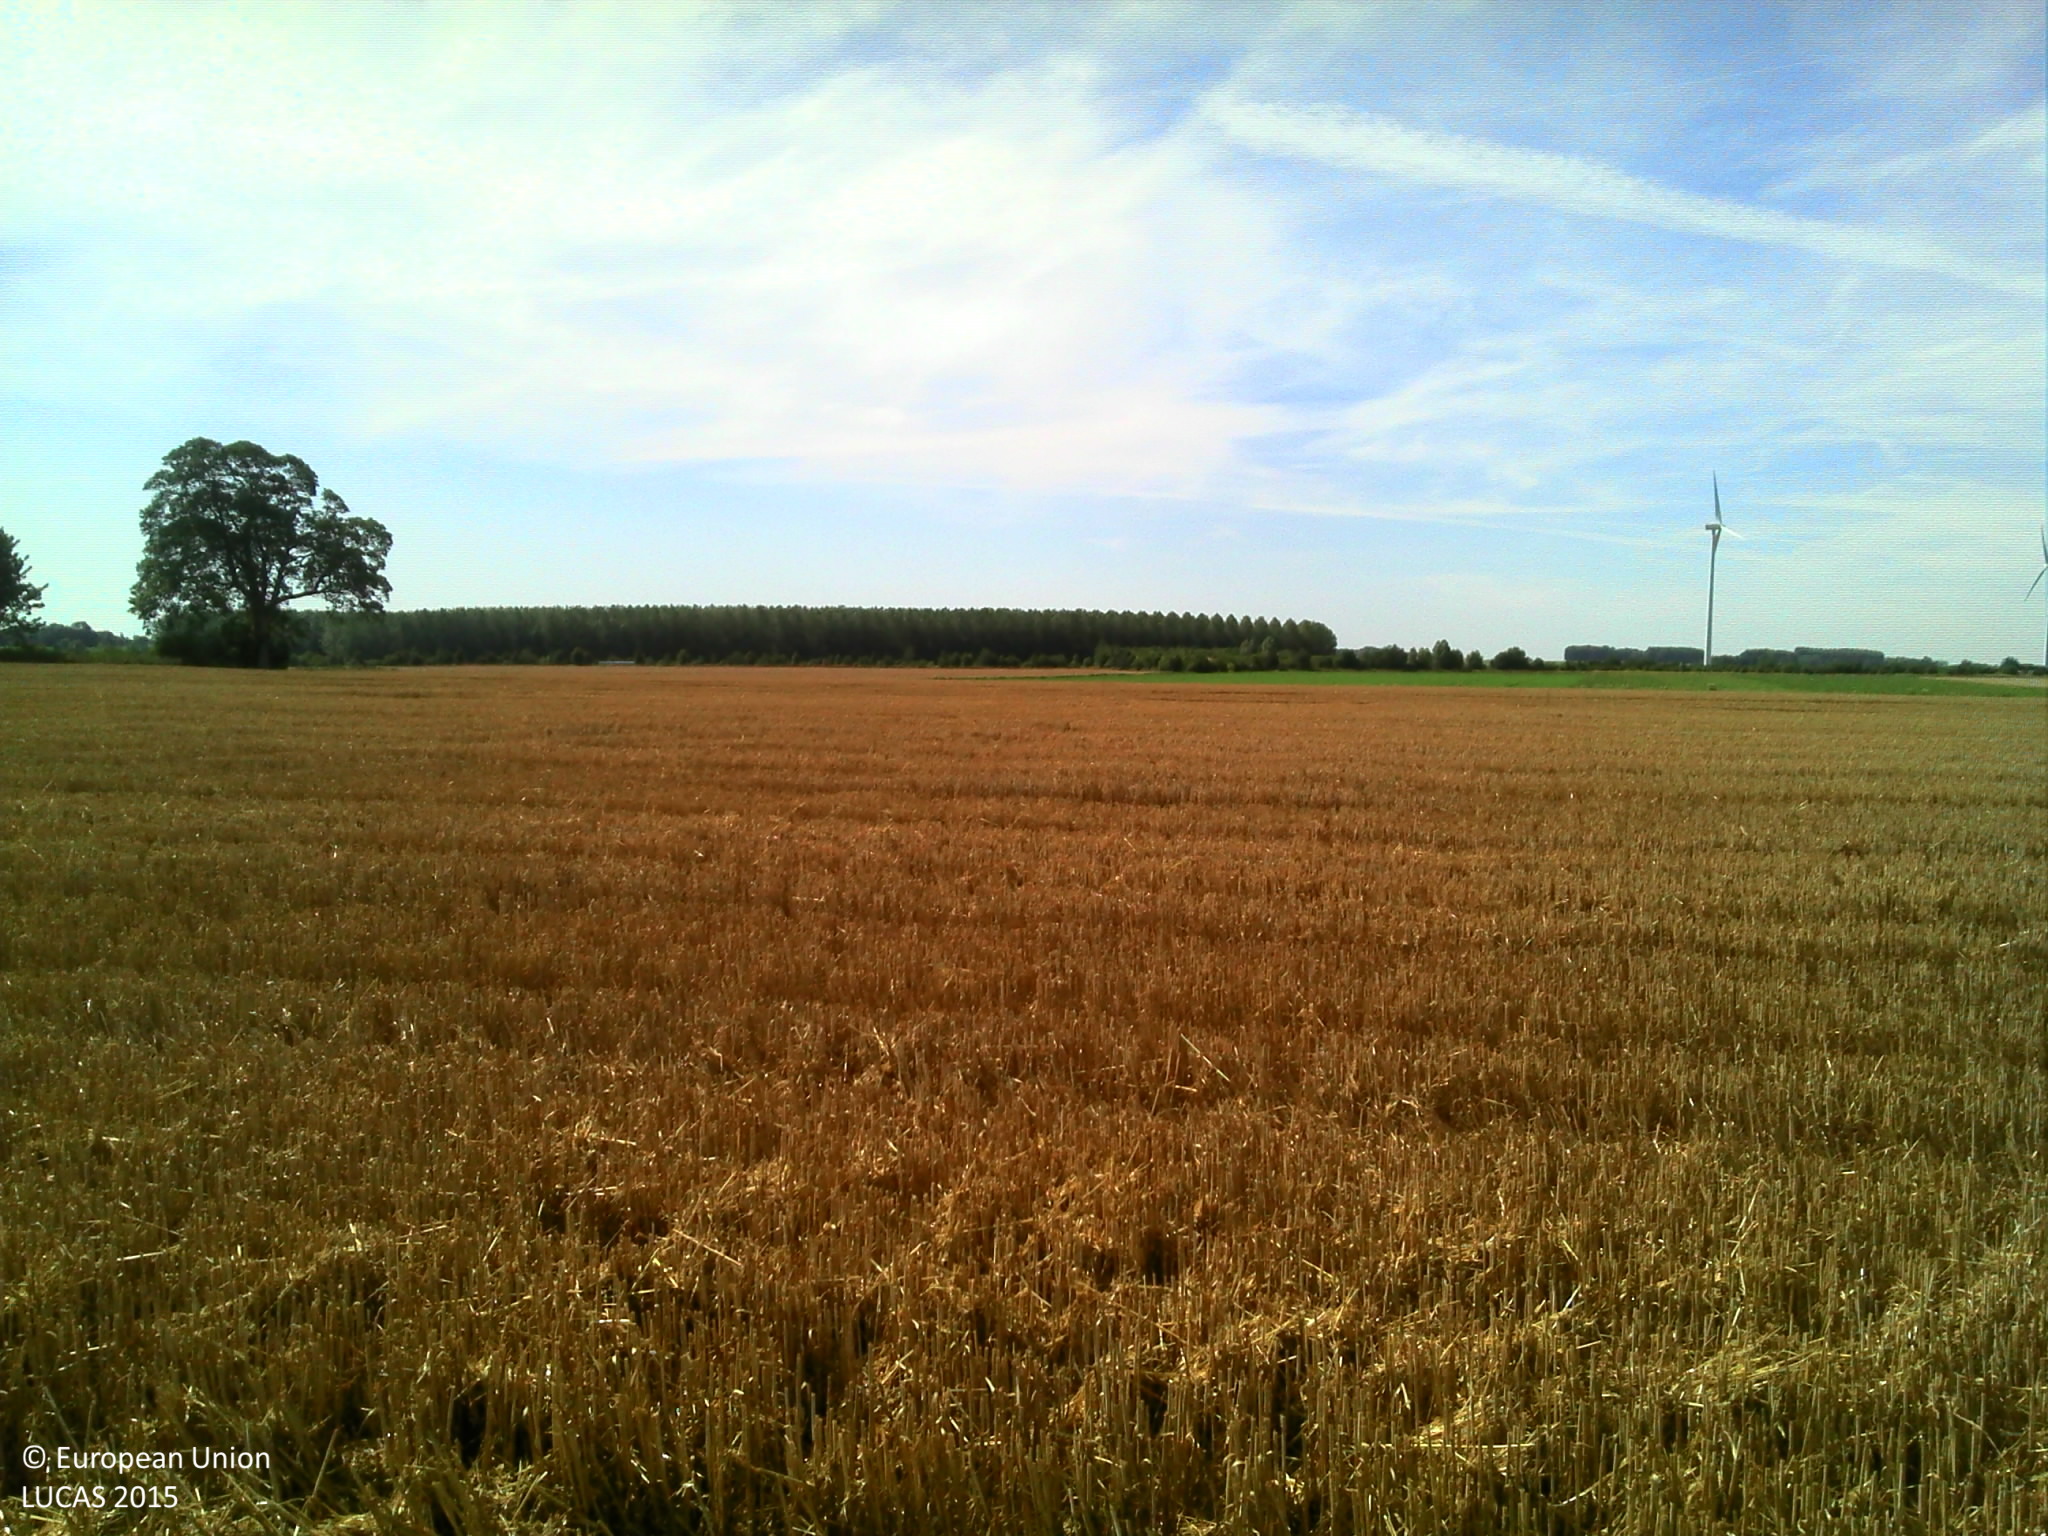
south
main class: Cropland
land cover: Common wheat
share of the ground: > 75 %
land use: Agriculture (excluding fallow land and kitchen gardens)
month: August
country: FR
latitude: 49.8642
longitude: 2.7689
